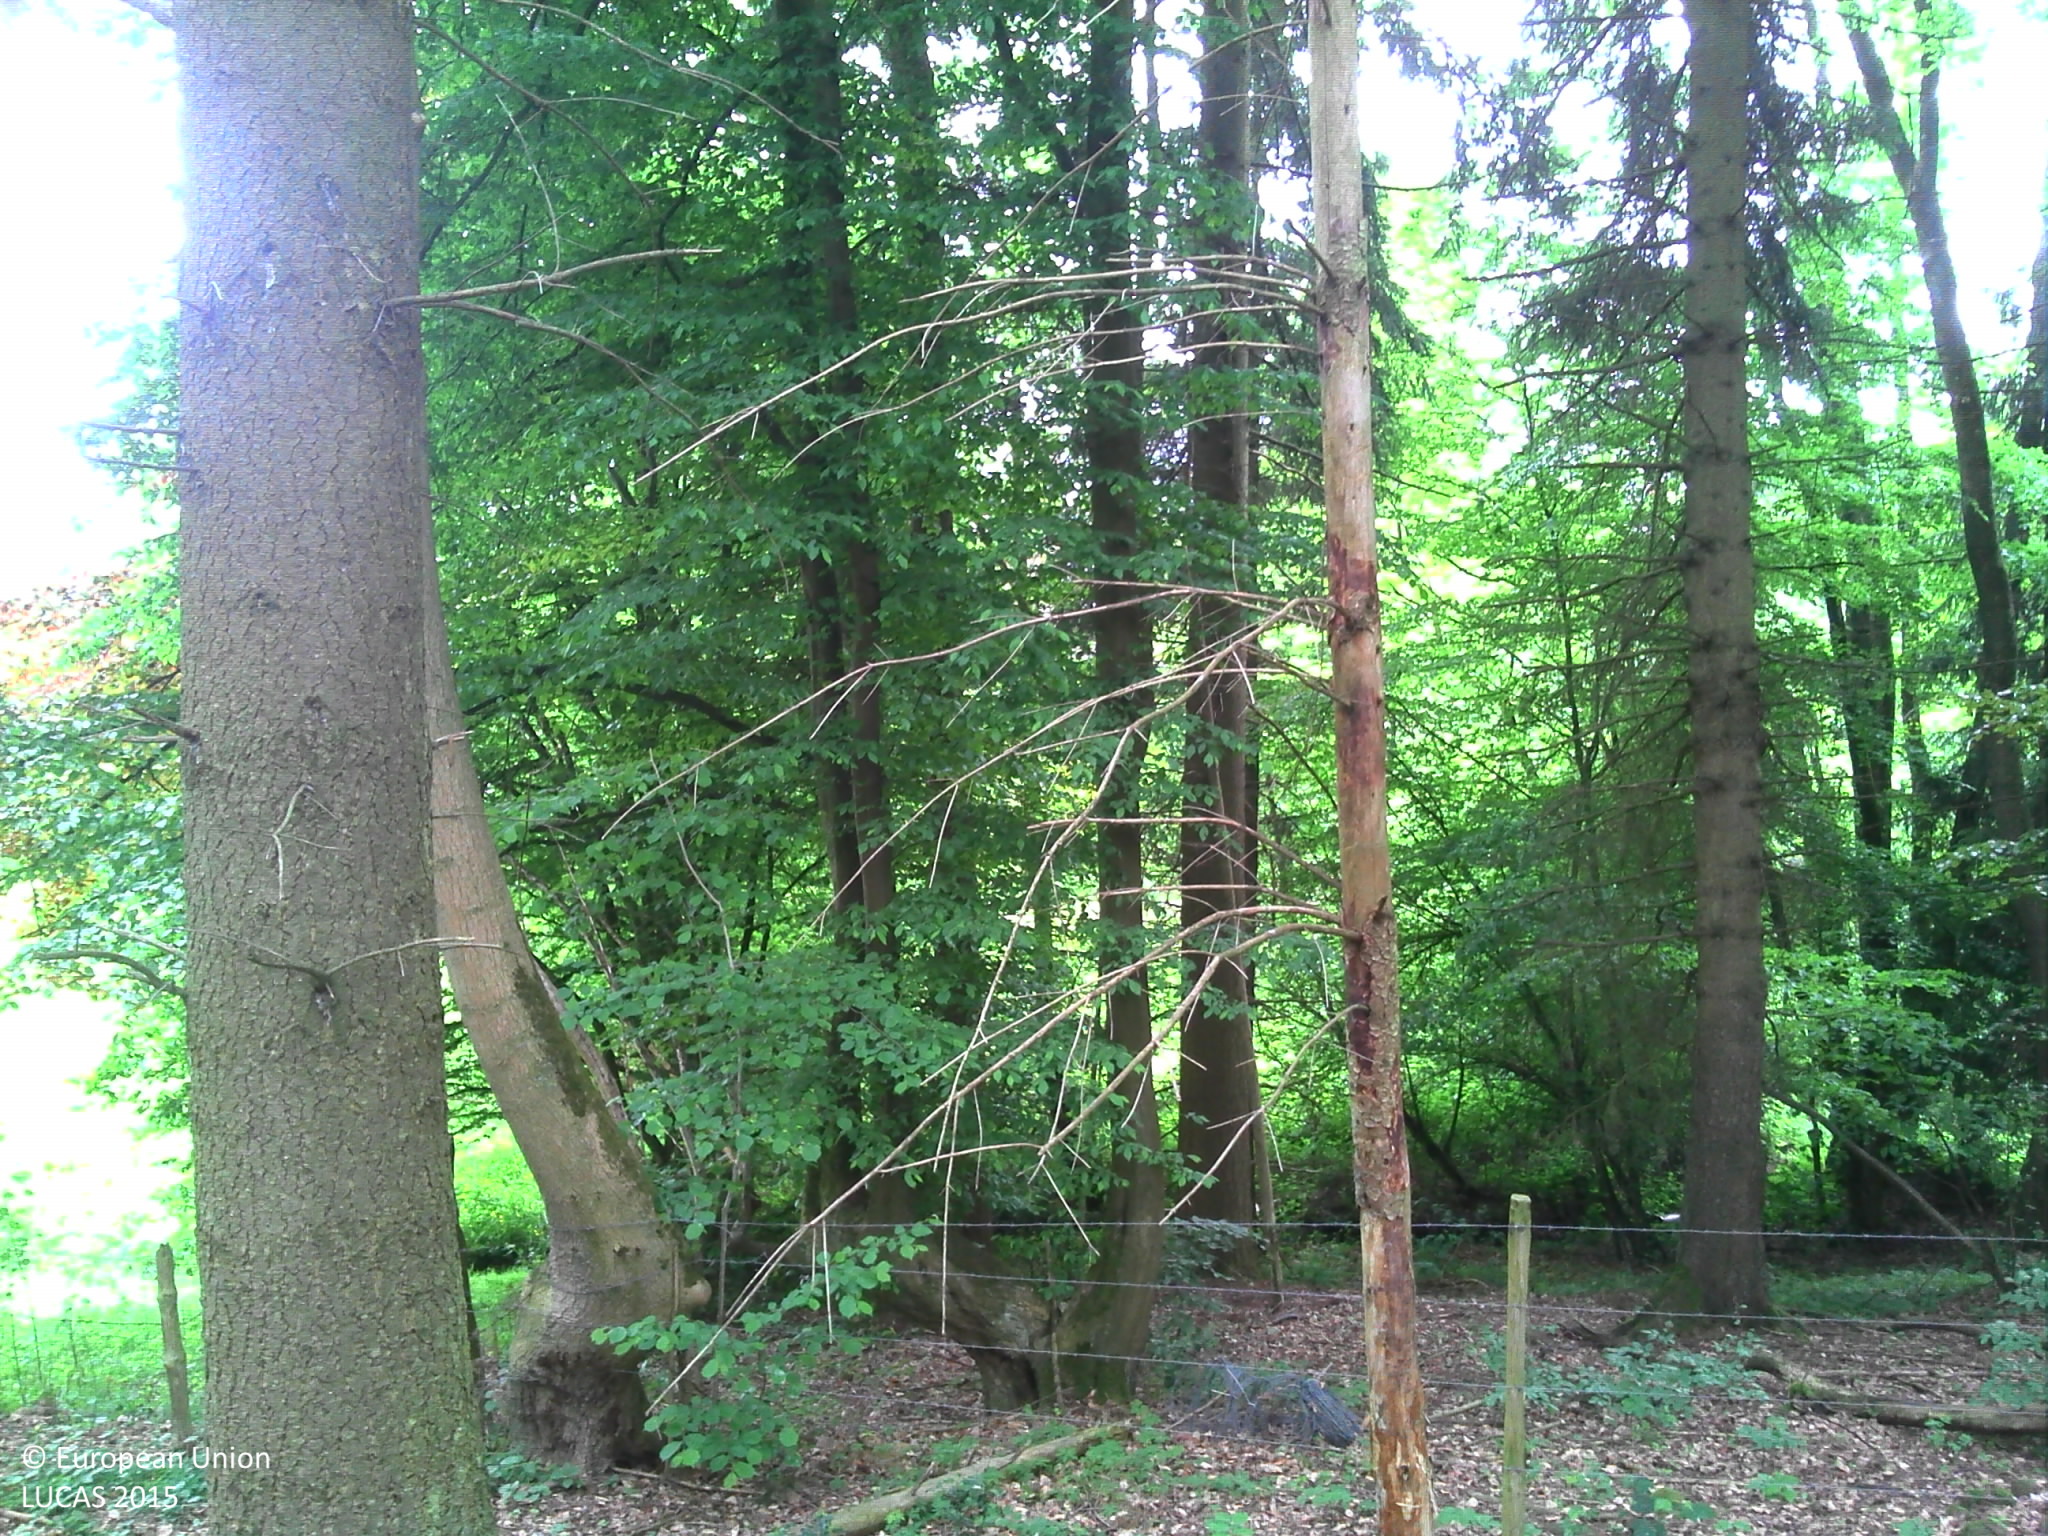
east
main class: Woodland
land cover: Other coniferous woodland
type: exotic forest
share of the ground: > 75 %
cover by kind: coniferous forest trees 90 %, herbaceous plants 10 %
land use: Forestry
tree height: > 5 m
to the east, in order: Other coniferous woodland; Fences; Spruce dominated mixed woodland; Rivers and streams; Spruce dominated mixed woodland; Shrubland without tree cover; Artificial constructions in urban areas; Abandoned hedges; Grass margins; Artificial constructions in urban areas; Grass margins; Fences; Grassland with sparse tree/shrub cover; Fences; Grassland without tree/shrub cover; Fences; Managed hedges; Grass margins; Paved roads, cycling and walking lanes; Grass margins; Artificial constructions in urban areas
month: June
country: BE
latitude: 50.3884
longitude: 5.6242
